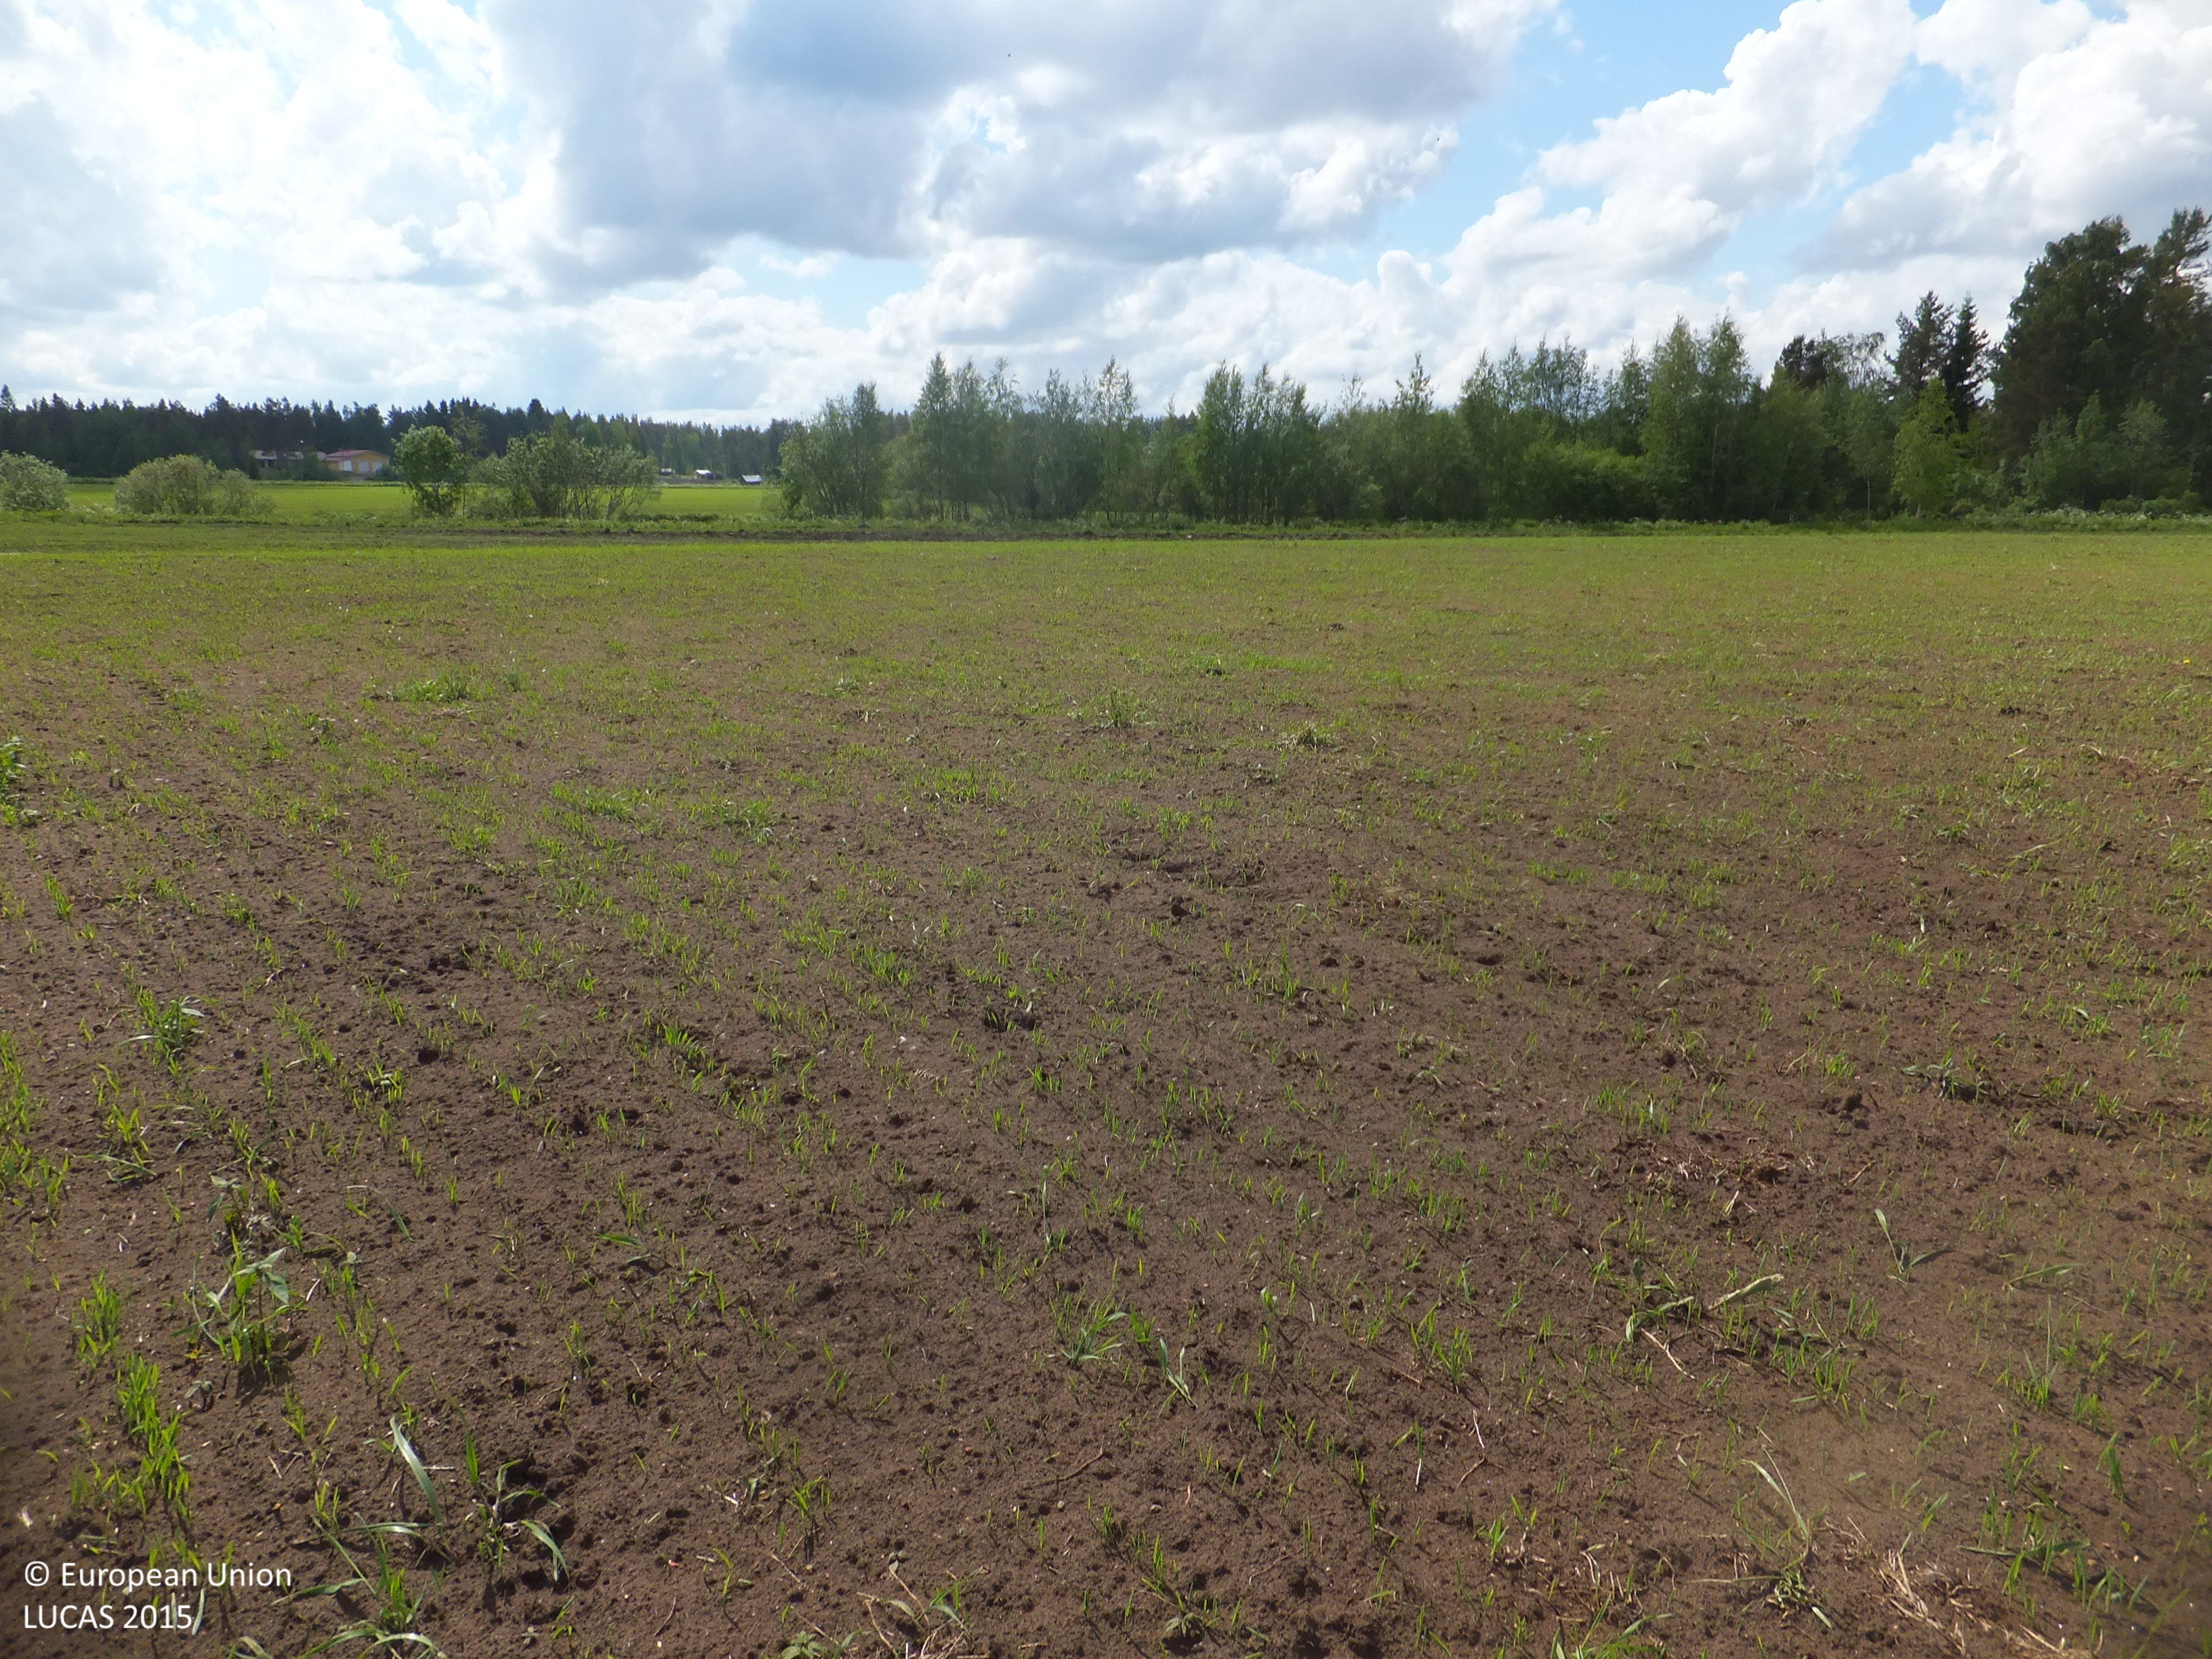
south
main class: Cropland
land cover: Barley
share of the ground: < 10 %
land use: Agriculture (excluding fallow land and kitchen gardens)
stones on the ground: < 10 %
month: June
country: FI
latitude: 63.6006
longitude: 24.0813
